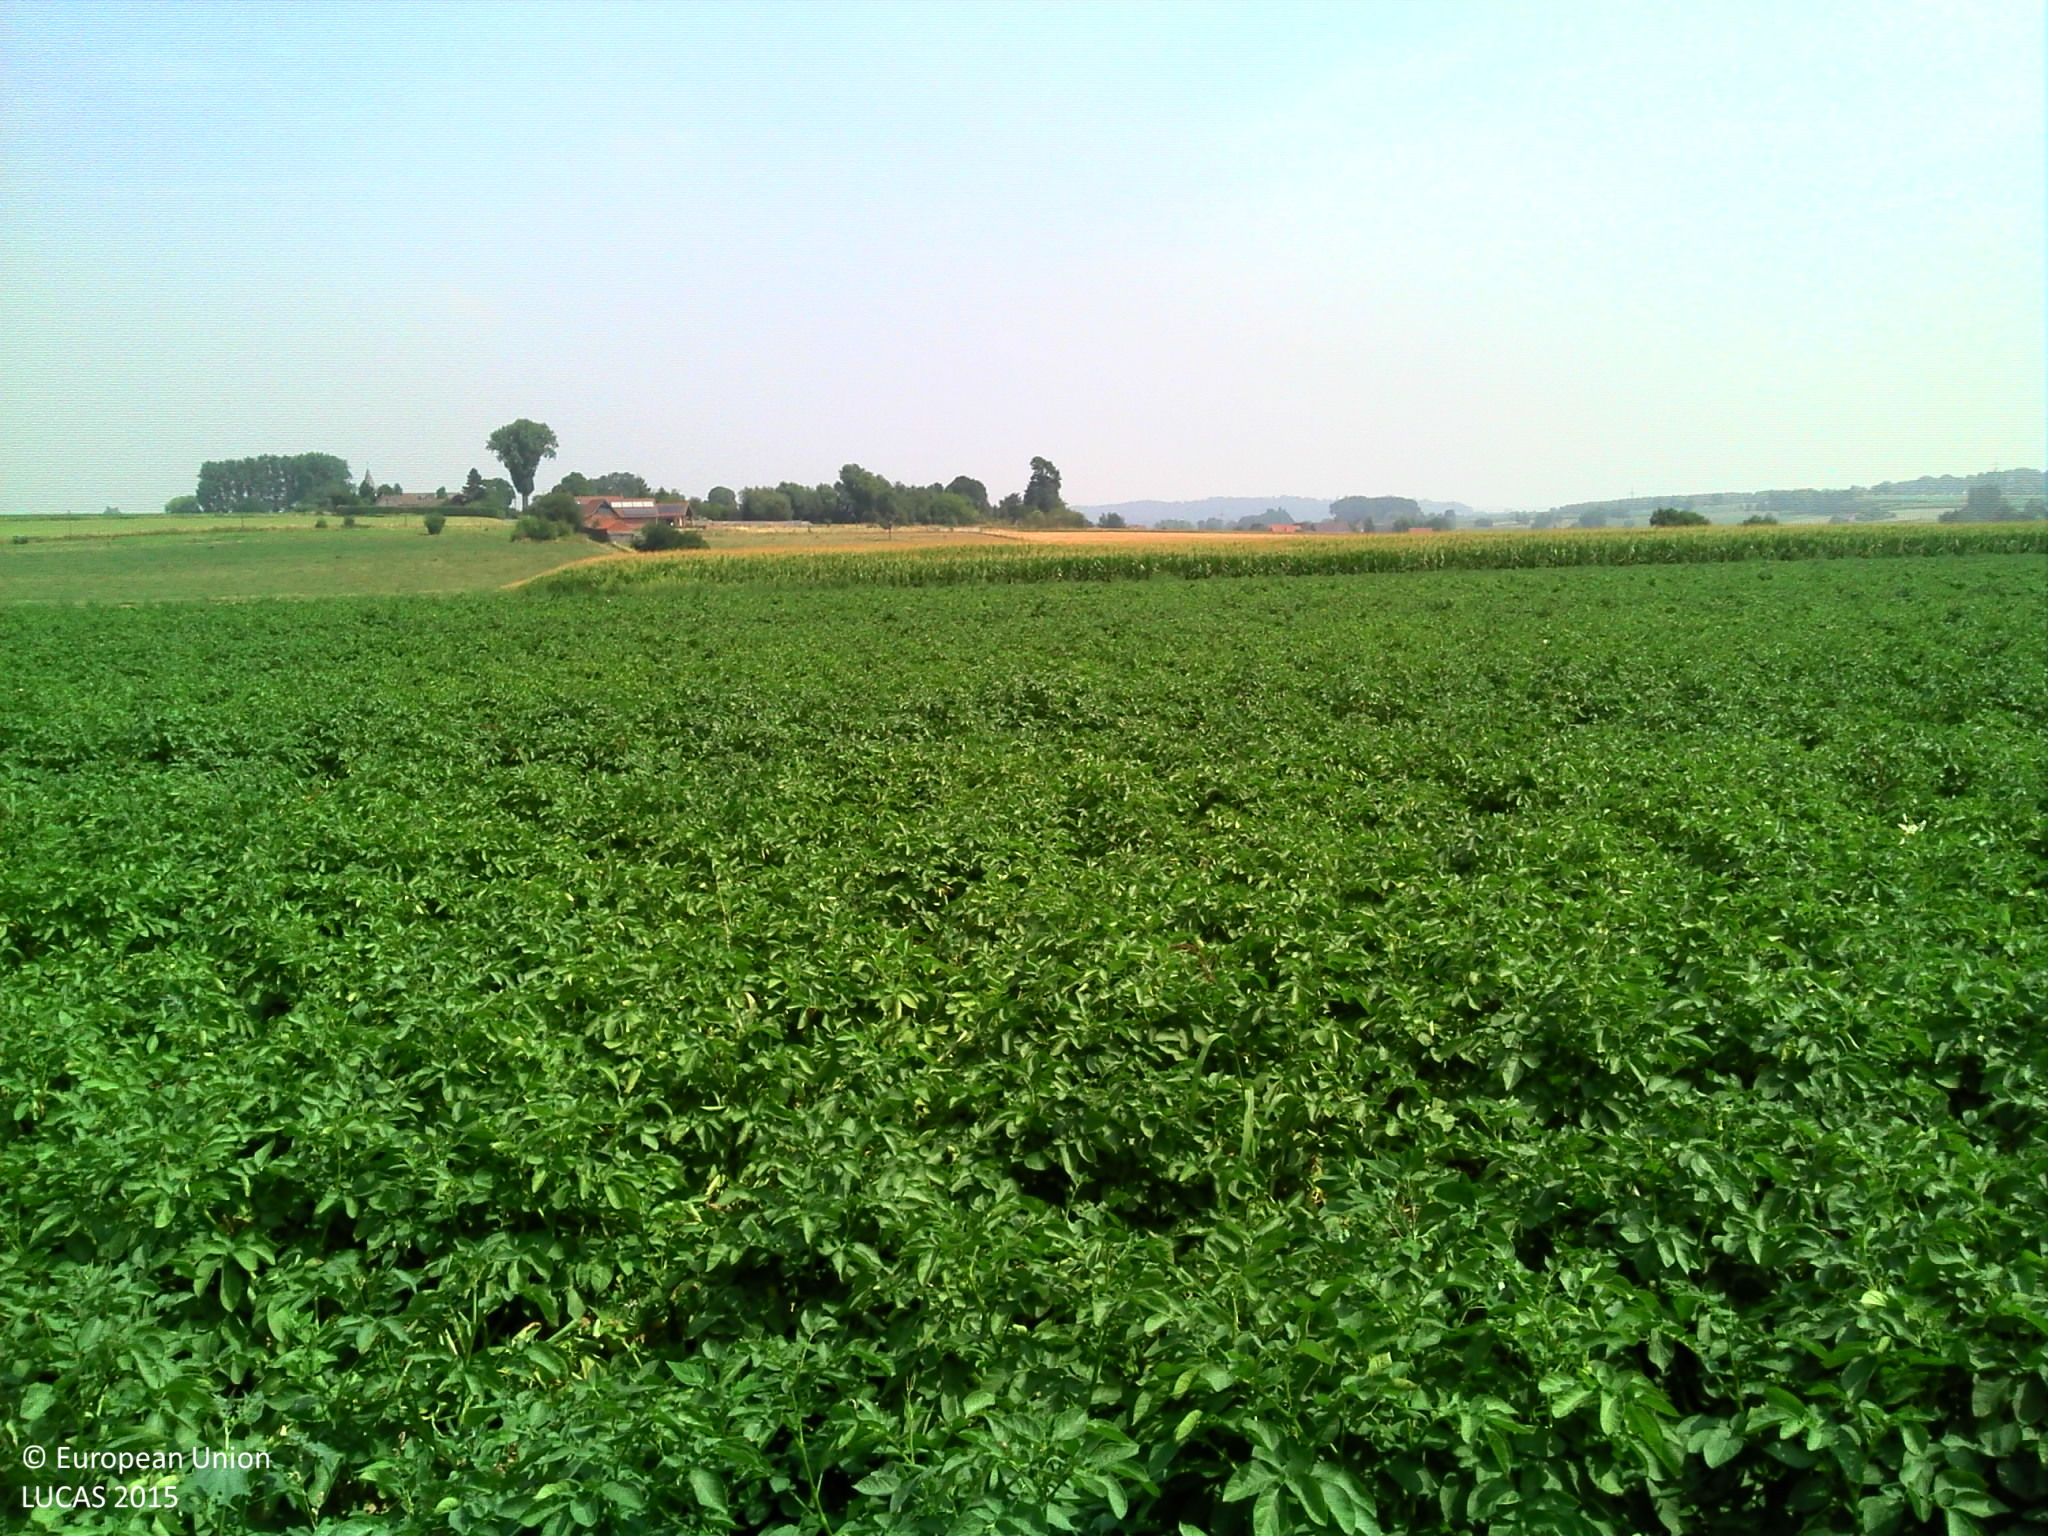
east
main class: Cropland
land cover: Maize
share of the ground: > 75 %
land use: Agriculture (excluding fallow land and kitchen gardens)
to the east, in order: Maize; Grass margins; Potatoes; Maize; Common wheat
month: August
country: BE
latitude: 50.6677
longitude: 3.5264
